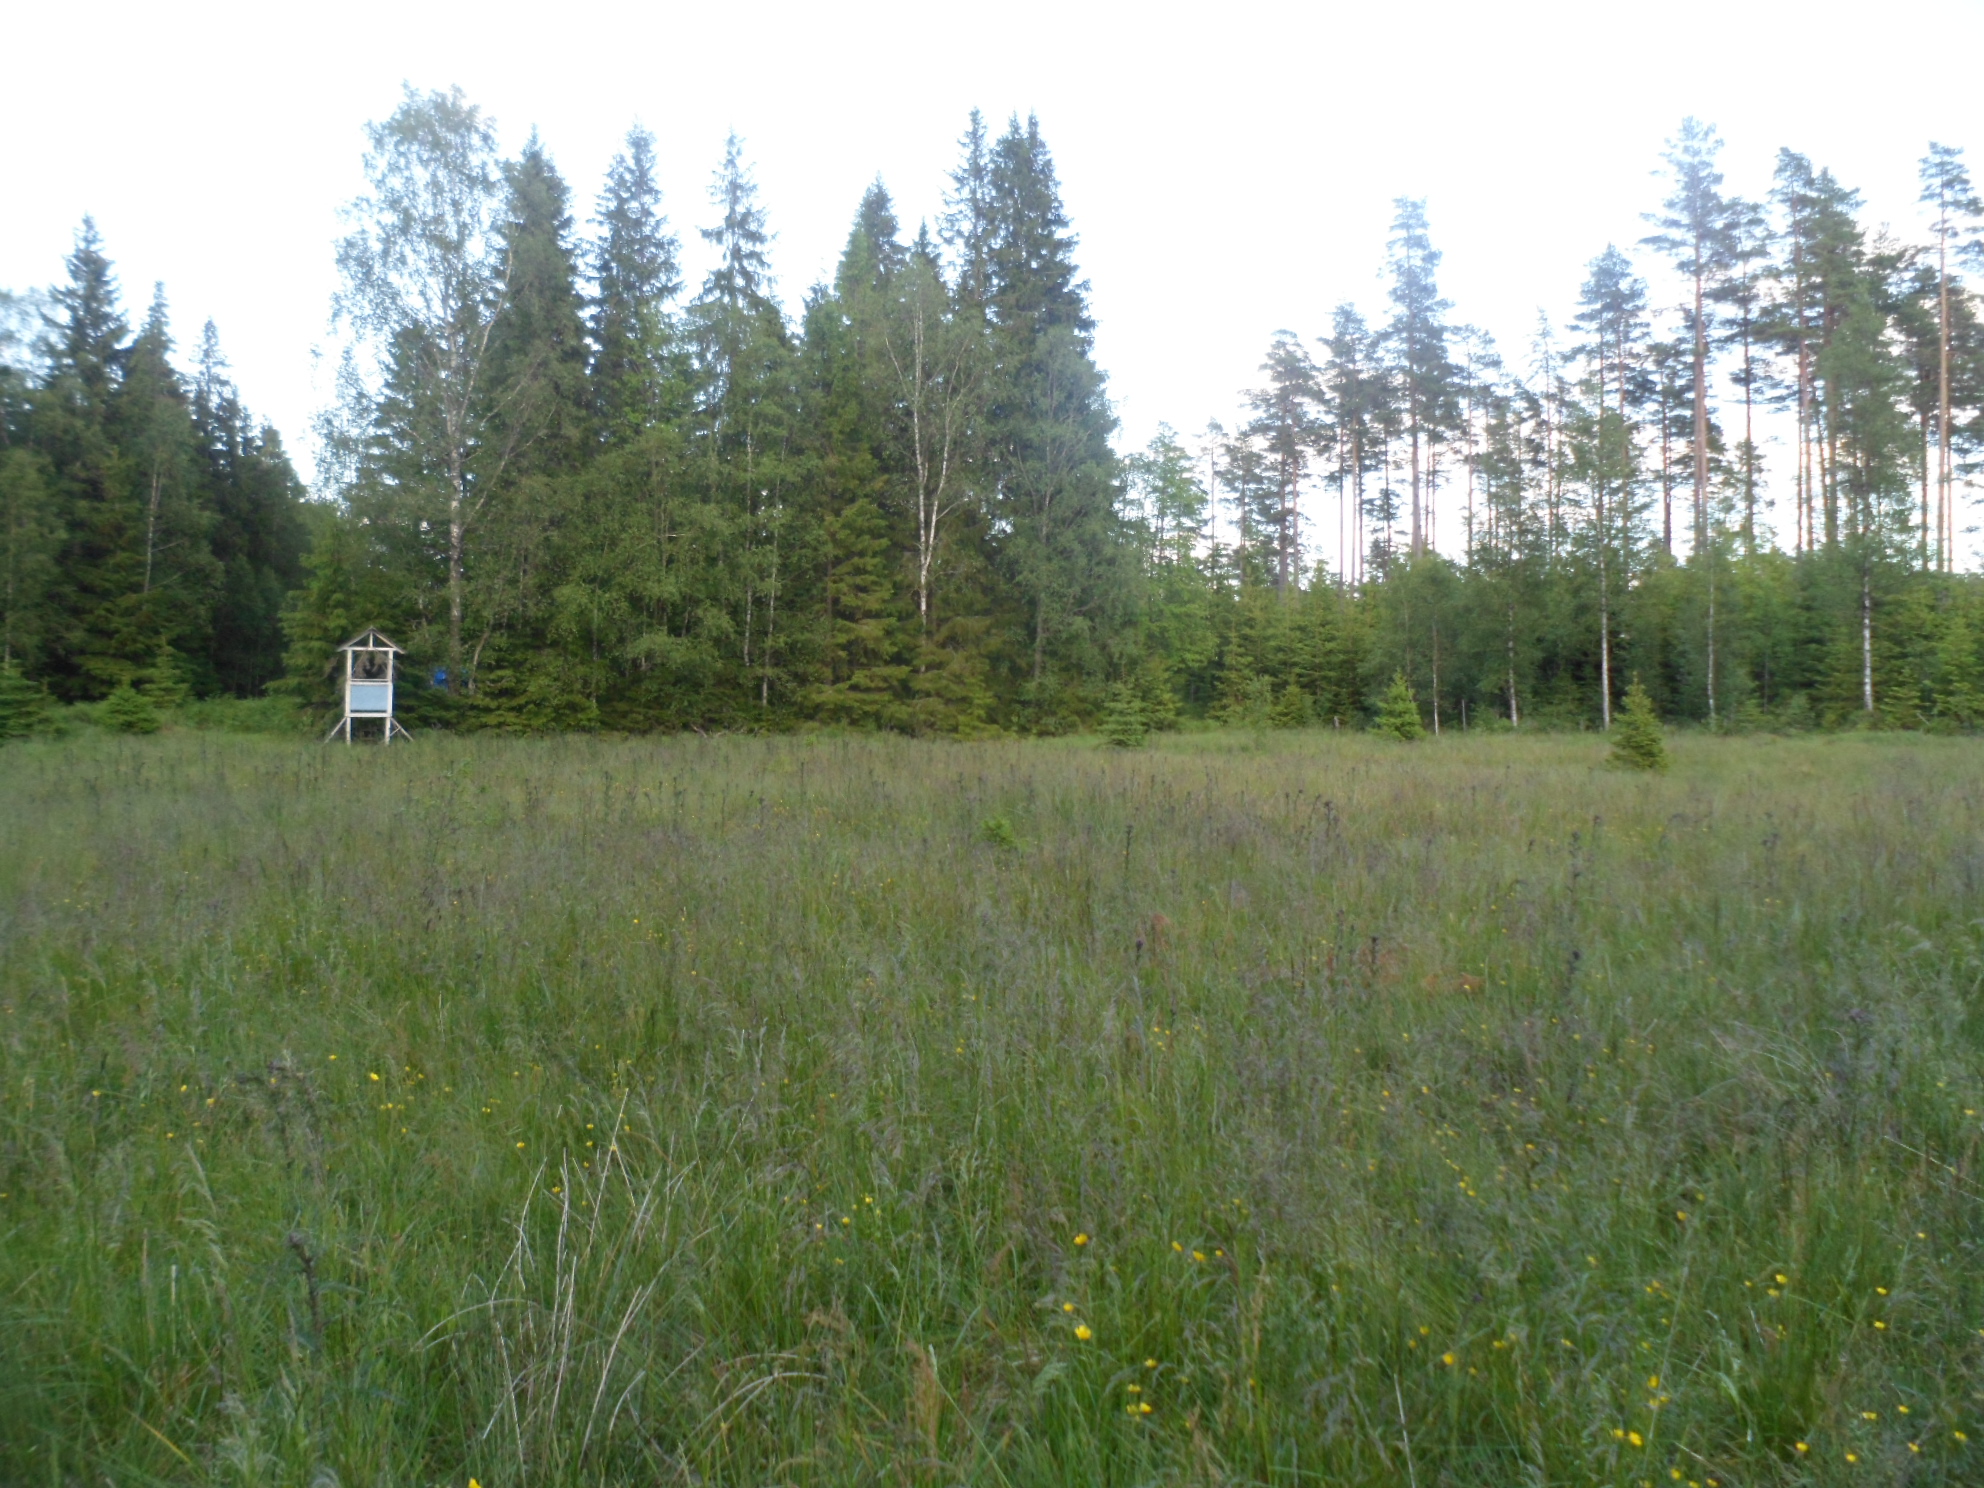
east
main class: Grassland
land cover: Grassland without tree/shrub cover
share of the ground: > 75 %
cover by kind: herbaceous plants 100 %
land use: Agriculture (excluding fallow land and kitchen gardens)
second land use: Amenities, museums, leisure
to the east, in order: Grassland without tree/shrub cover; Spruce dominated mixed woodland; Grassland without tree/shrub cover; Ditches and canals; Fences; Spruce dominated mixed woodland; Tracks; Pine dominated coniferous woodland; Peatbogs; Spruce dominated coniferous woodland; Fences; Grassland with sparse tree/shrub cover
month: July
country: SE
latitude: 57.5713
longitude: 14.3928
